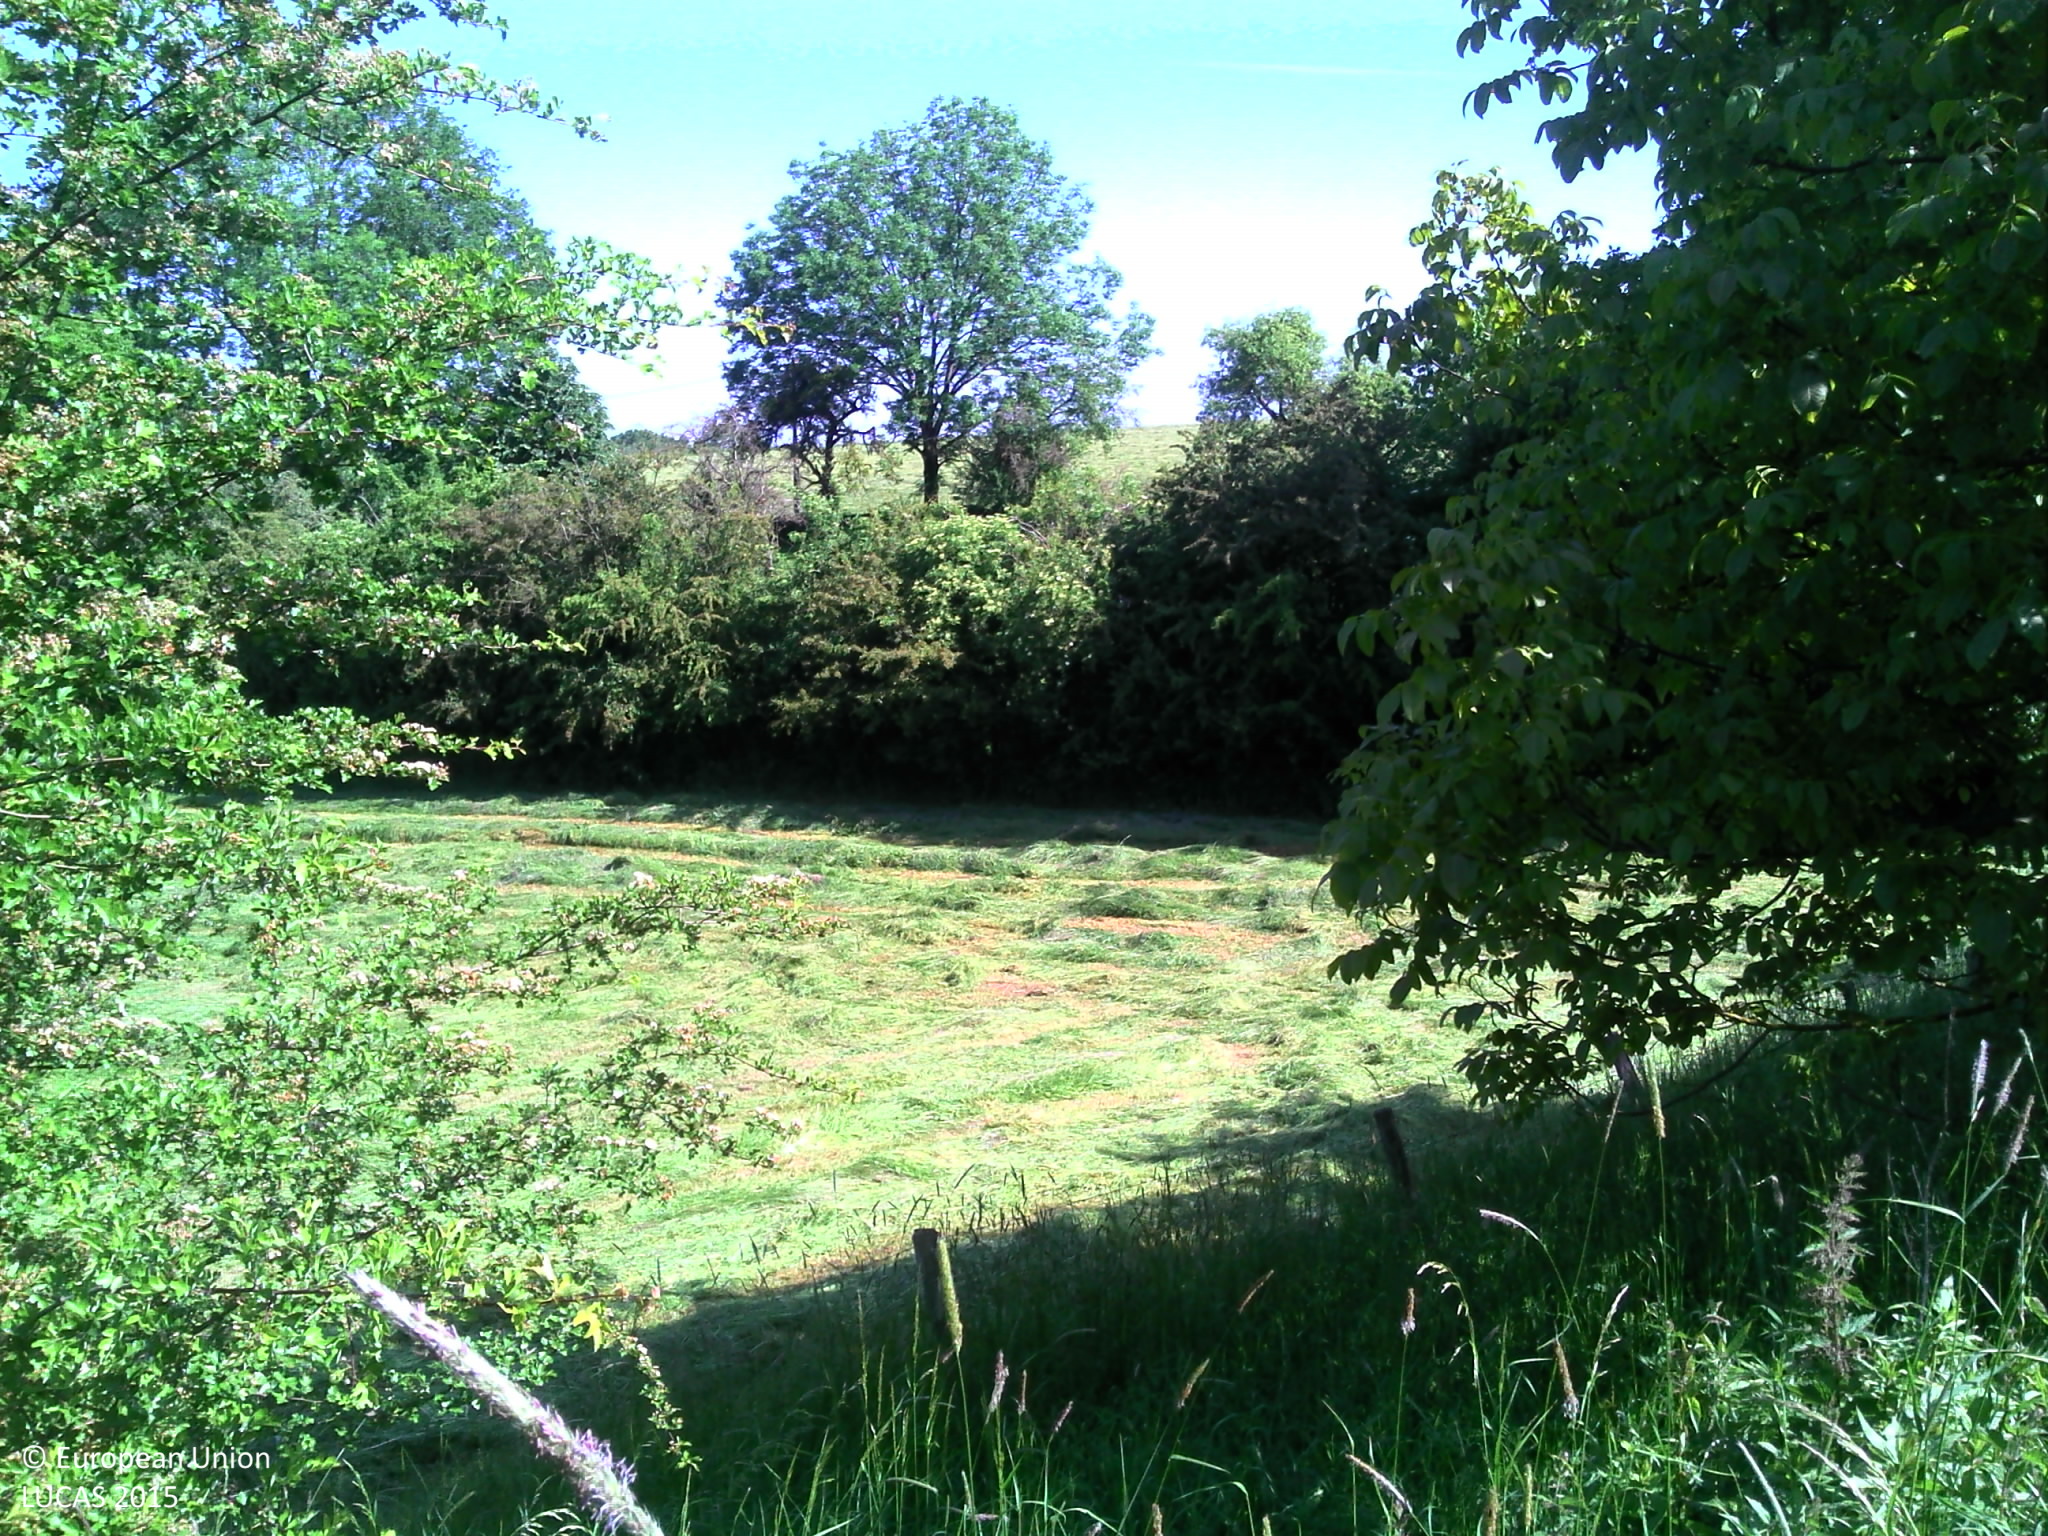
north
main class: Grassland
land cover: Spontaneously vegetated surfaces
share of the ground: > 75 %
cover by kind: herbaceous plants 100 %
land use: Semi-natural and natural areas not in use
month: June
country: BE
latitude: 50.5172
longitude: 5.6970
